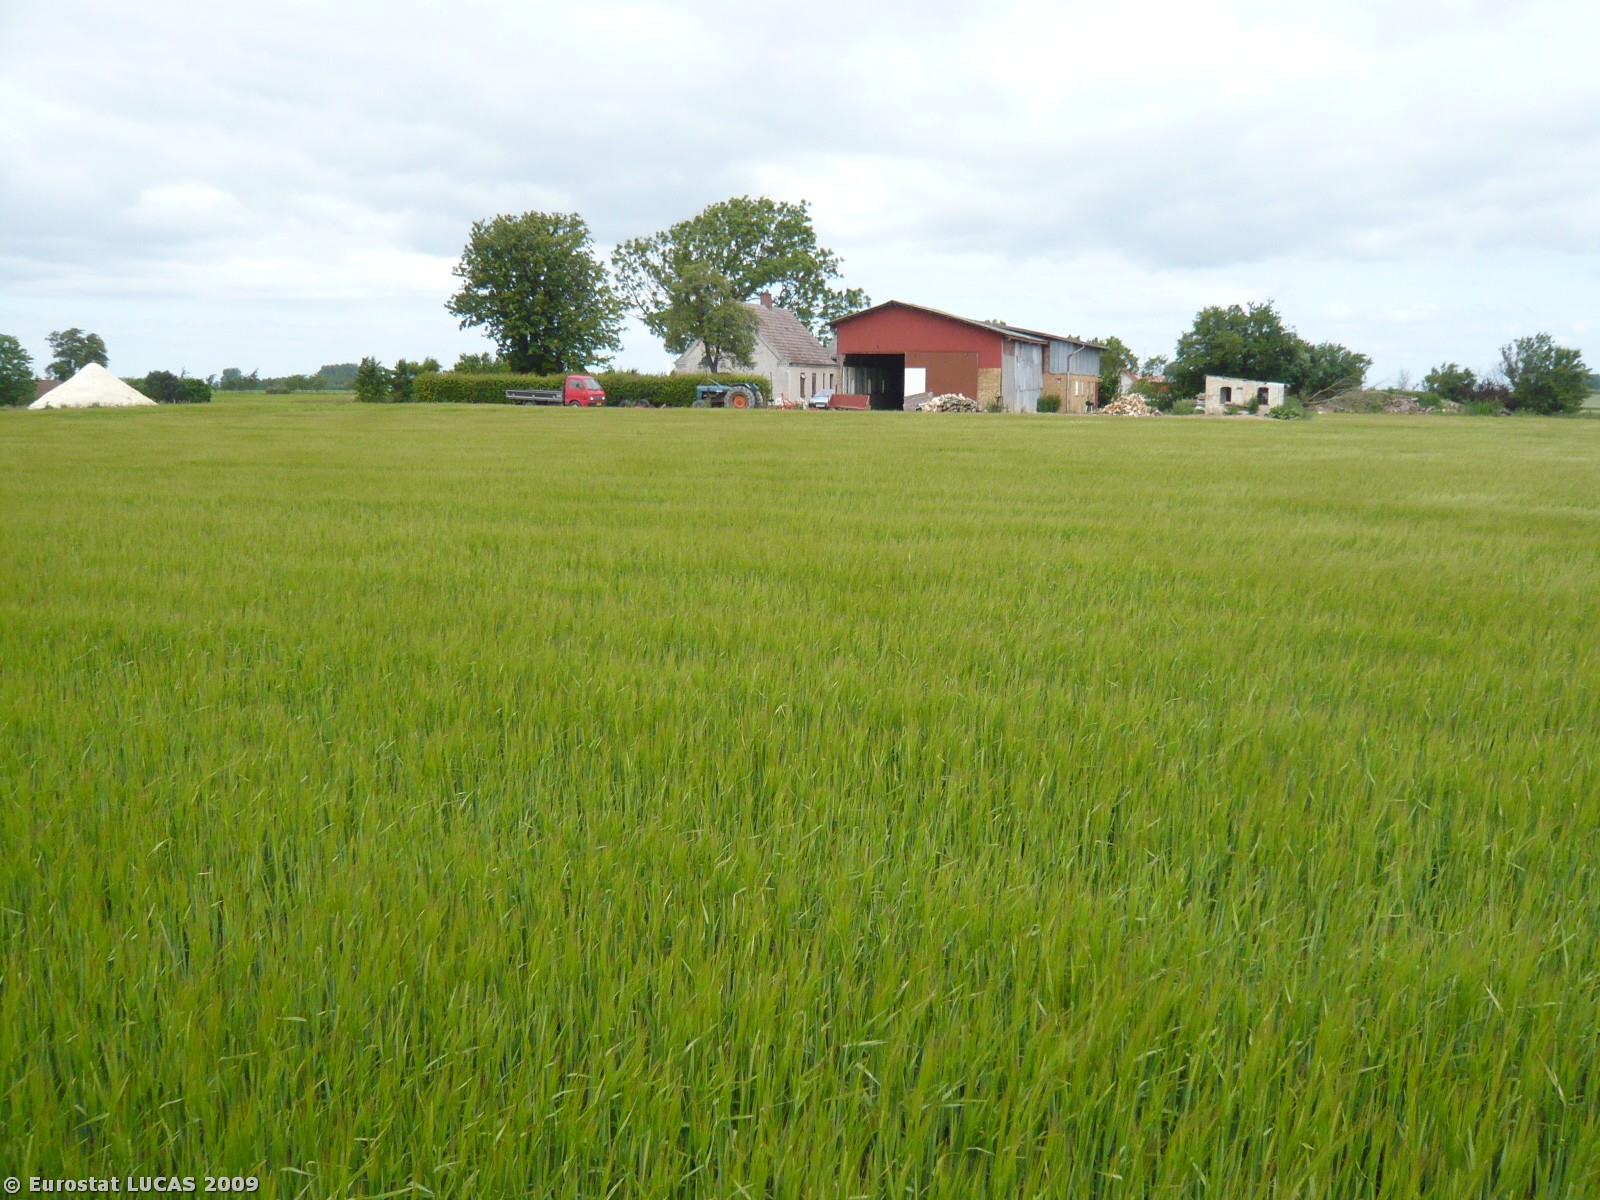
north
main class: Cropland
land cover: Barley
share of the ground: > 75 %
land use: Agriculture (excluding fallow land and kitchen gardens)
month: June
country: DK
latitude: 54.9415
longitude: 11.2323
